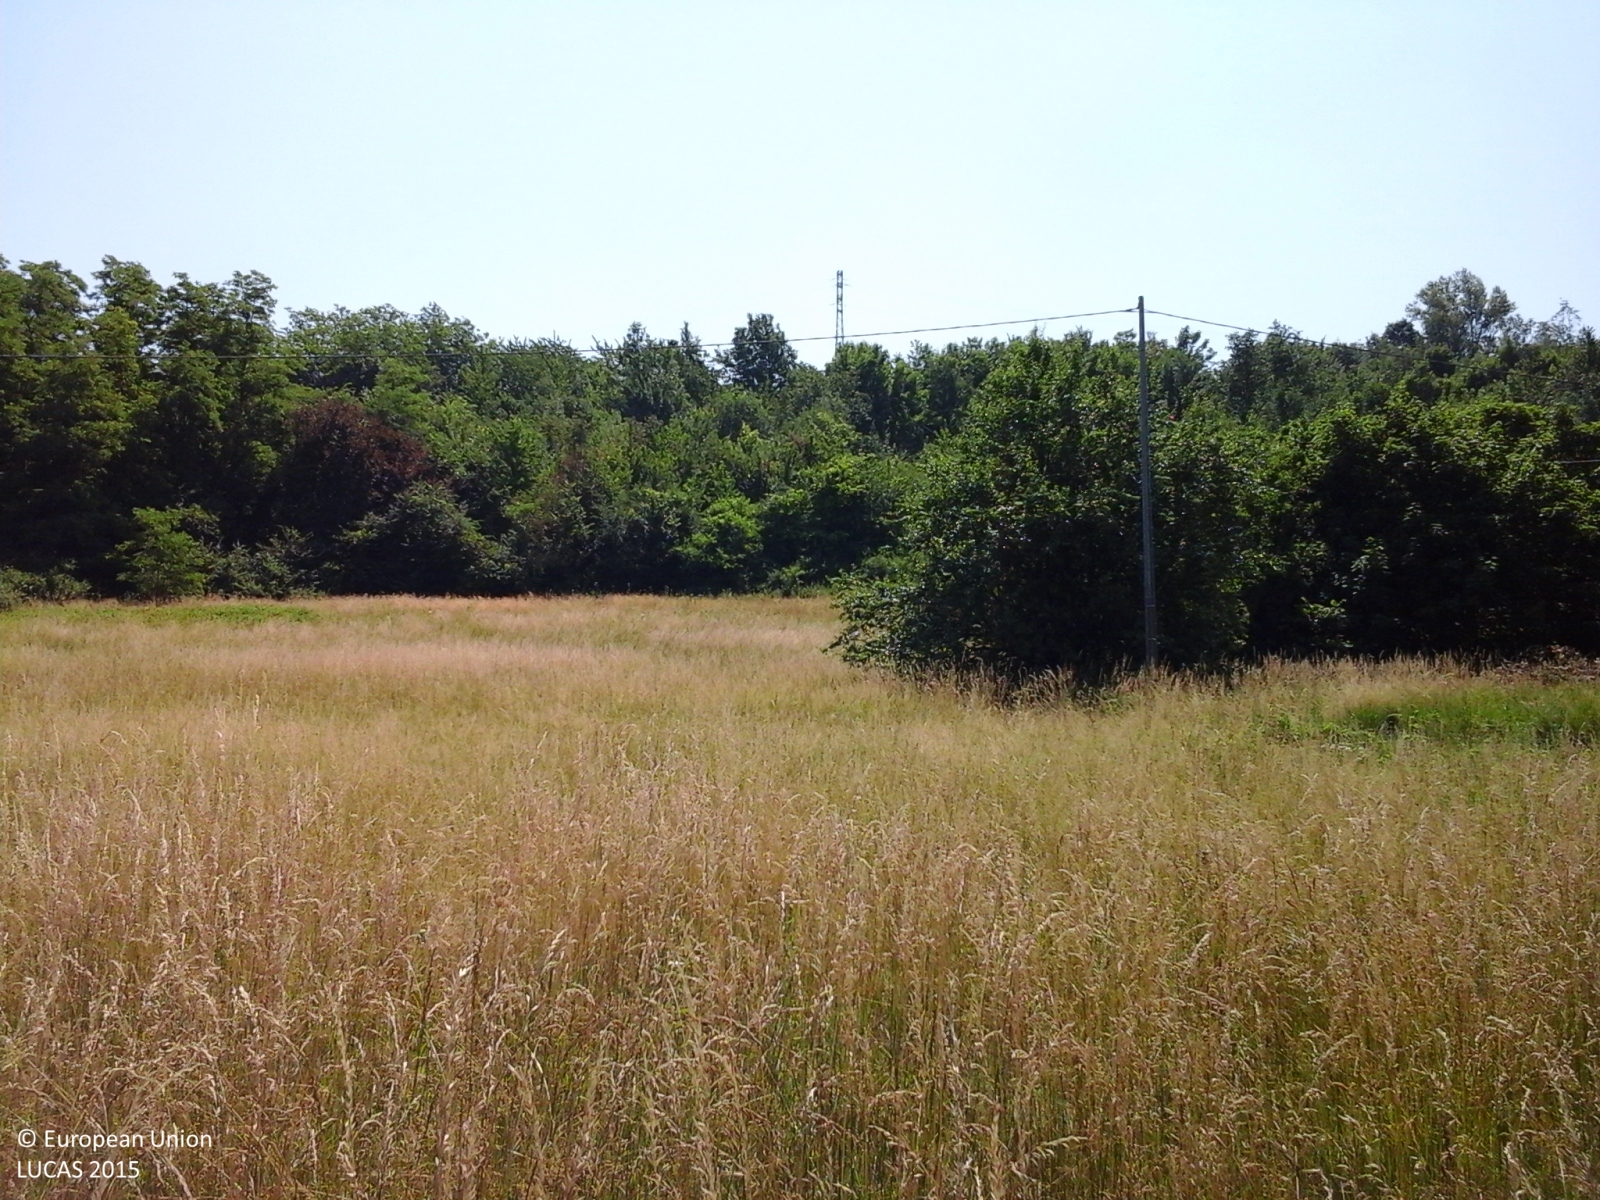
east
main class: Grassland
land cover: Grassland without tree/shrub cover
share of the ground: > 75 %
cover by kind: herbaceous plants 100 %
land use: Agriculture (excluding fallow land and kitchen gardens)
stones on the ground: 10 - 25 %
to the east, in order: Grassland without tree/shrub cover; Electric lines; Grassland without tree/shrub cover; Broadleaved woodland; Electric lines; Broadleaved woodland
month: June
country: IT
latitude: 44.6484
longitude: 8.6537
